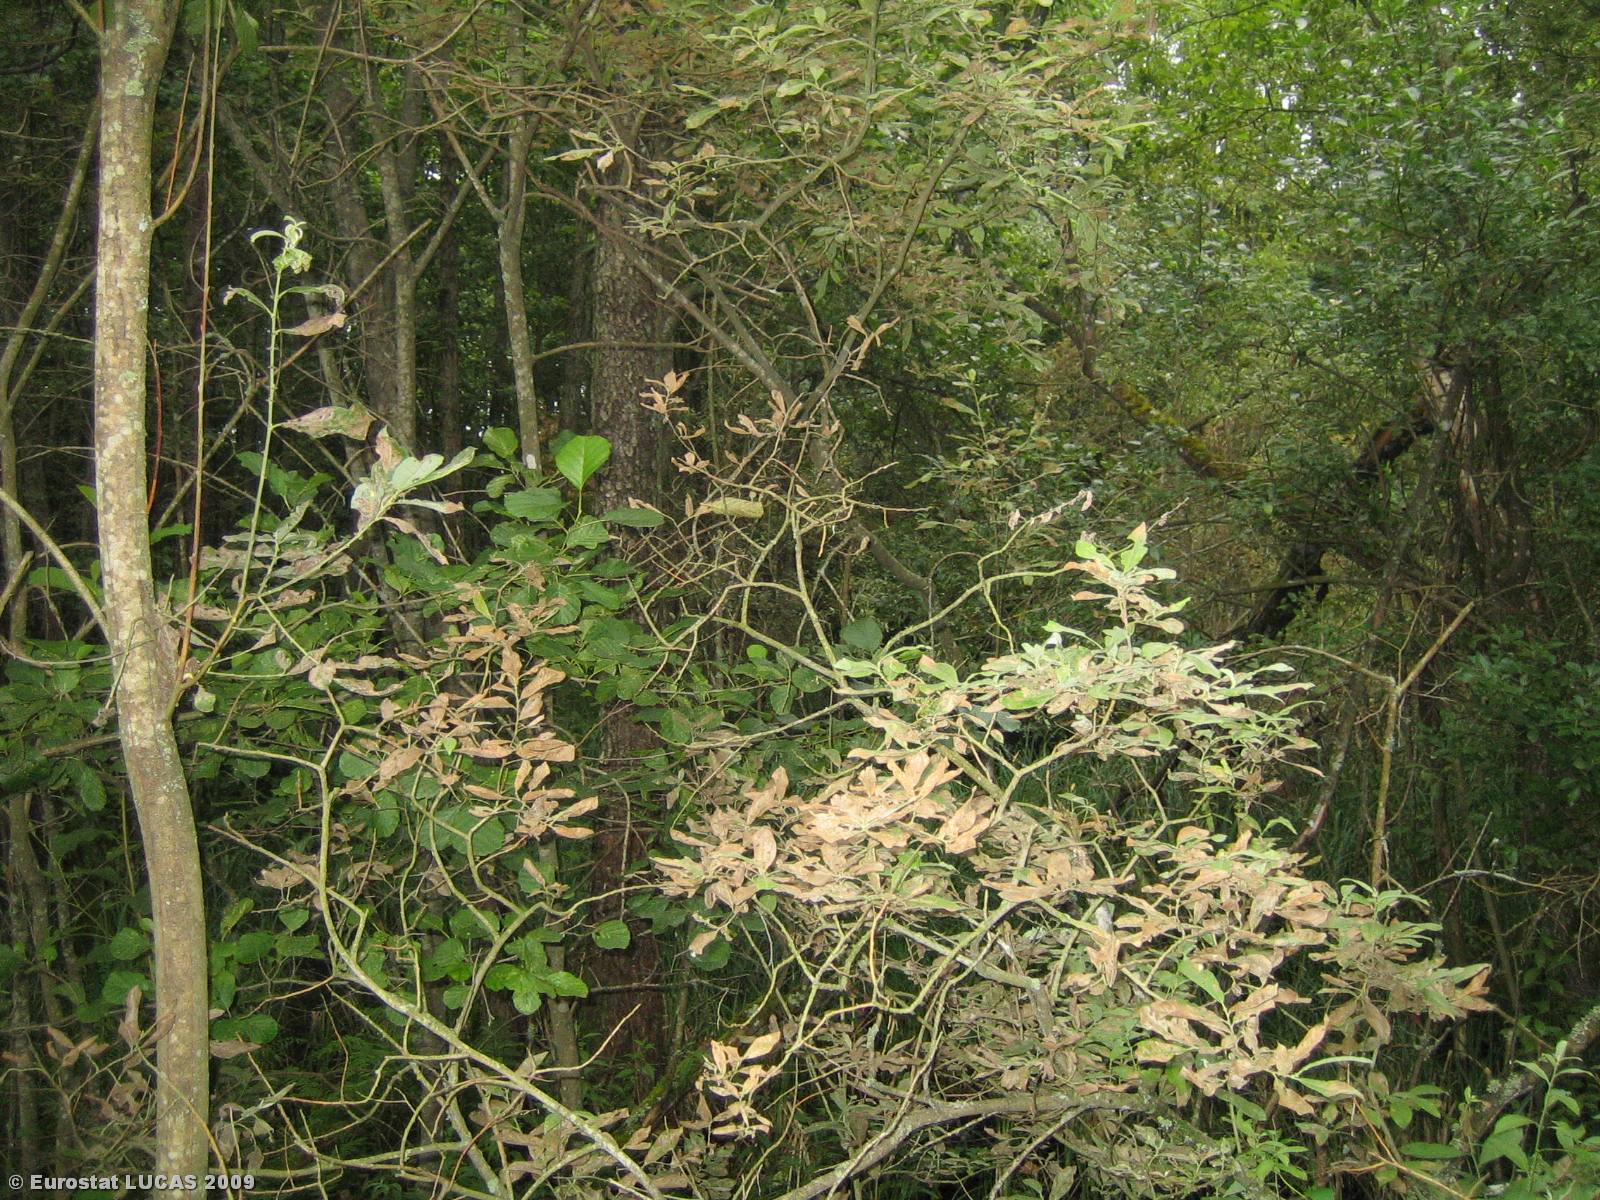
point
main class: Woodland
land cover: Broadleaved woodland
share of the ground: > 75 %
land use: Forestry
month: July
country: LT
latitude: 55.4989
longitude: 25.4629
